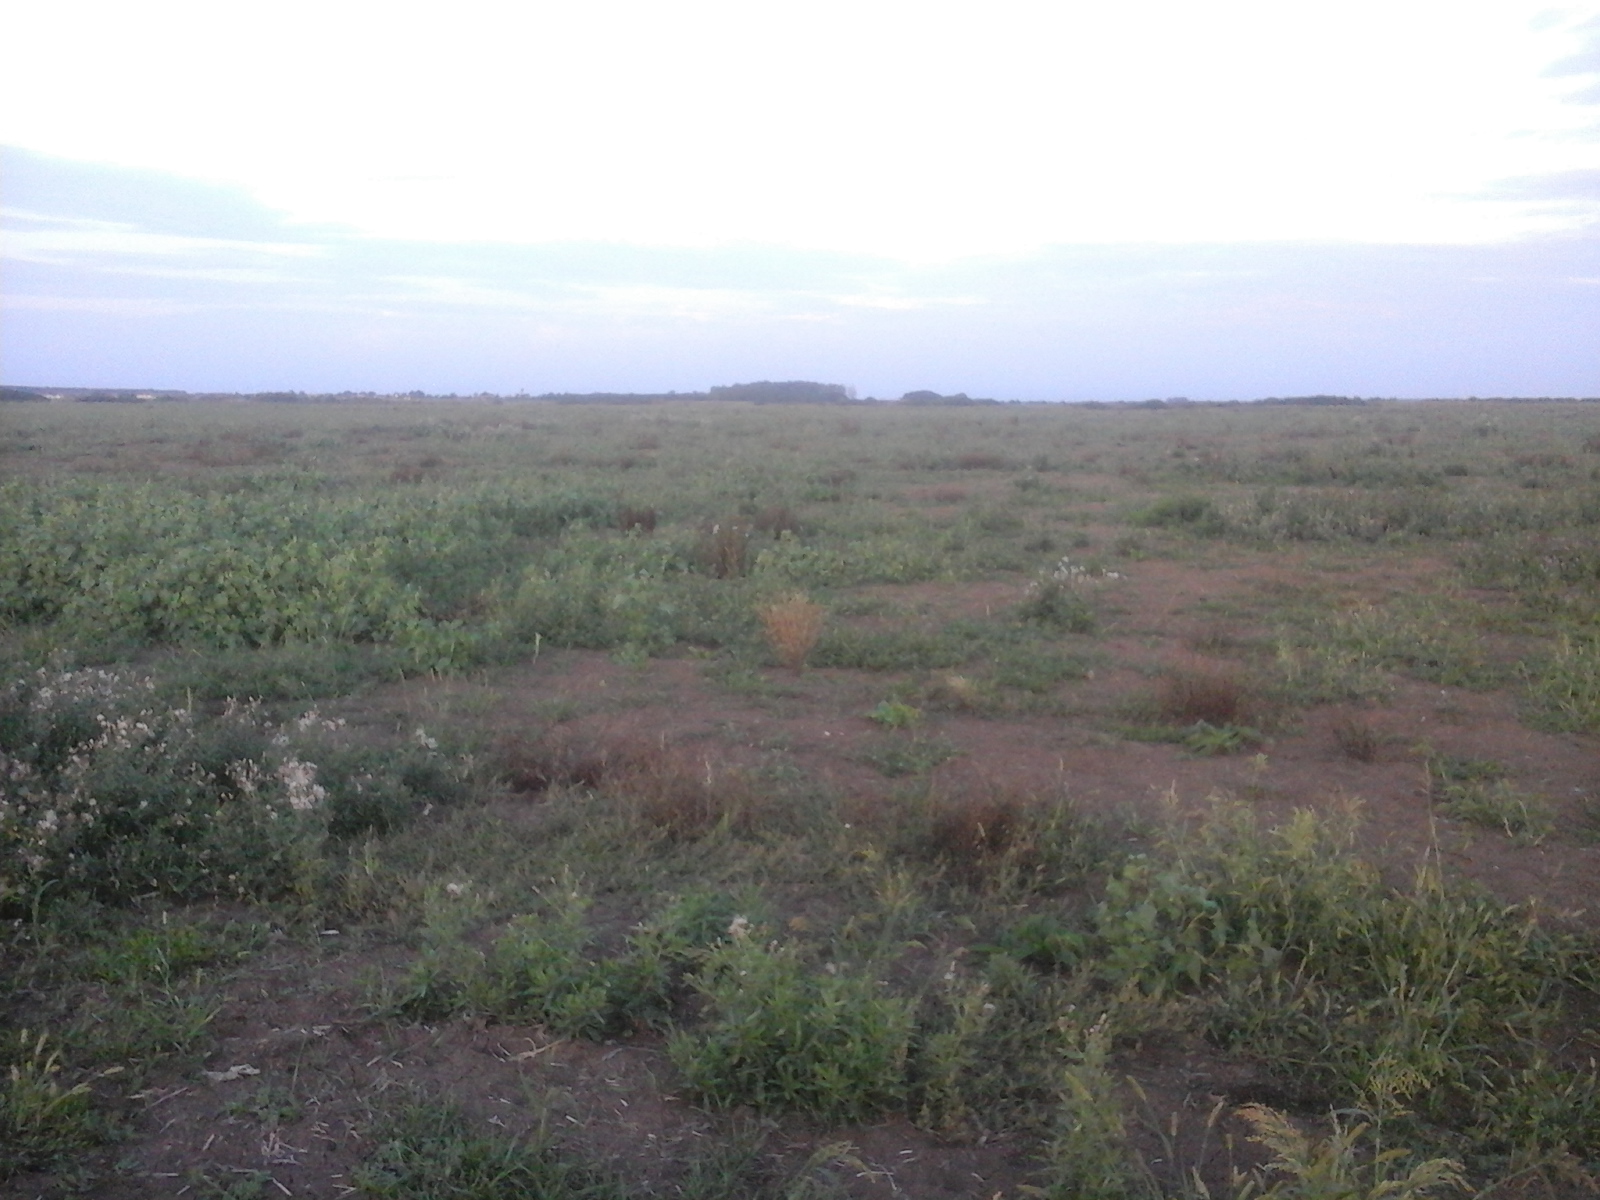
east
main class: Grassland
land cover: Spontaneously vegetated surfaces
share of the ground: > 75 %
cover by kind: herbaceous plants 100 %
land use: Agriculture (excluding fallow land and kitchen gardens)
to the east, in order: Spontaneously vegetated surfaces
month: August
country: RO
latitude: 46.6562
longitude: 21.4990
